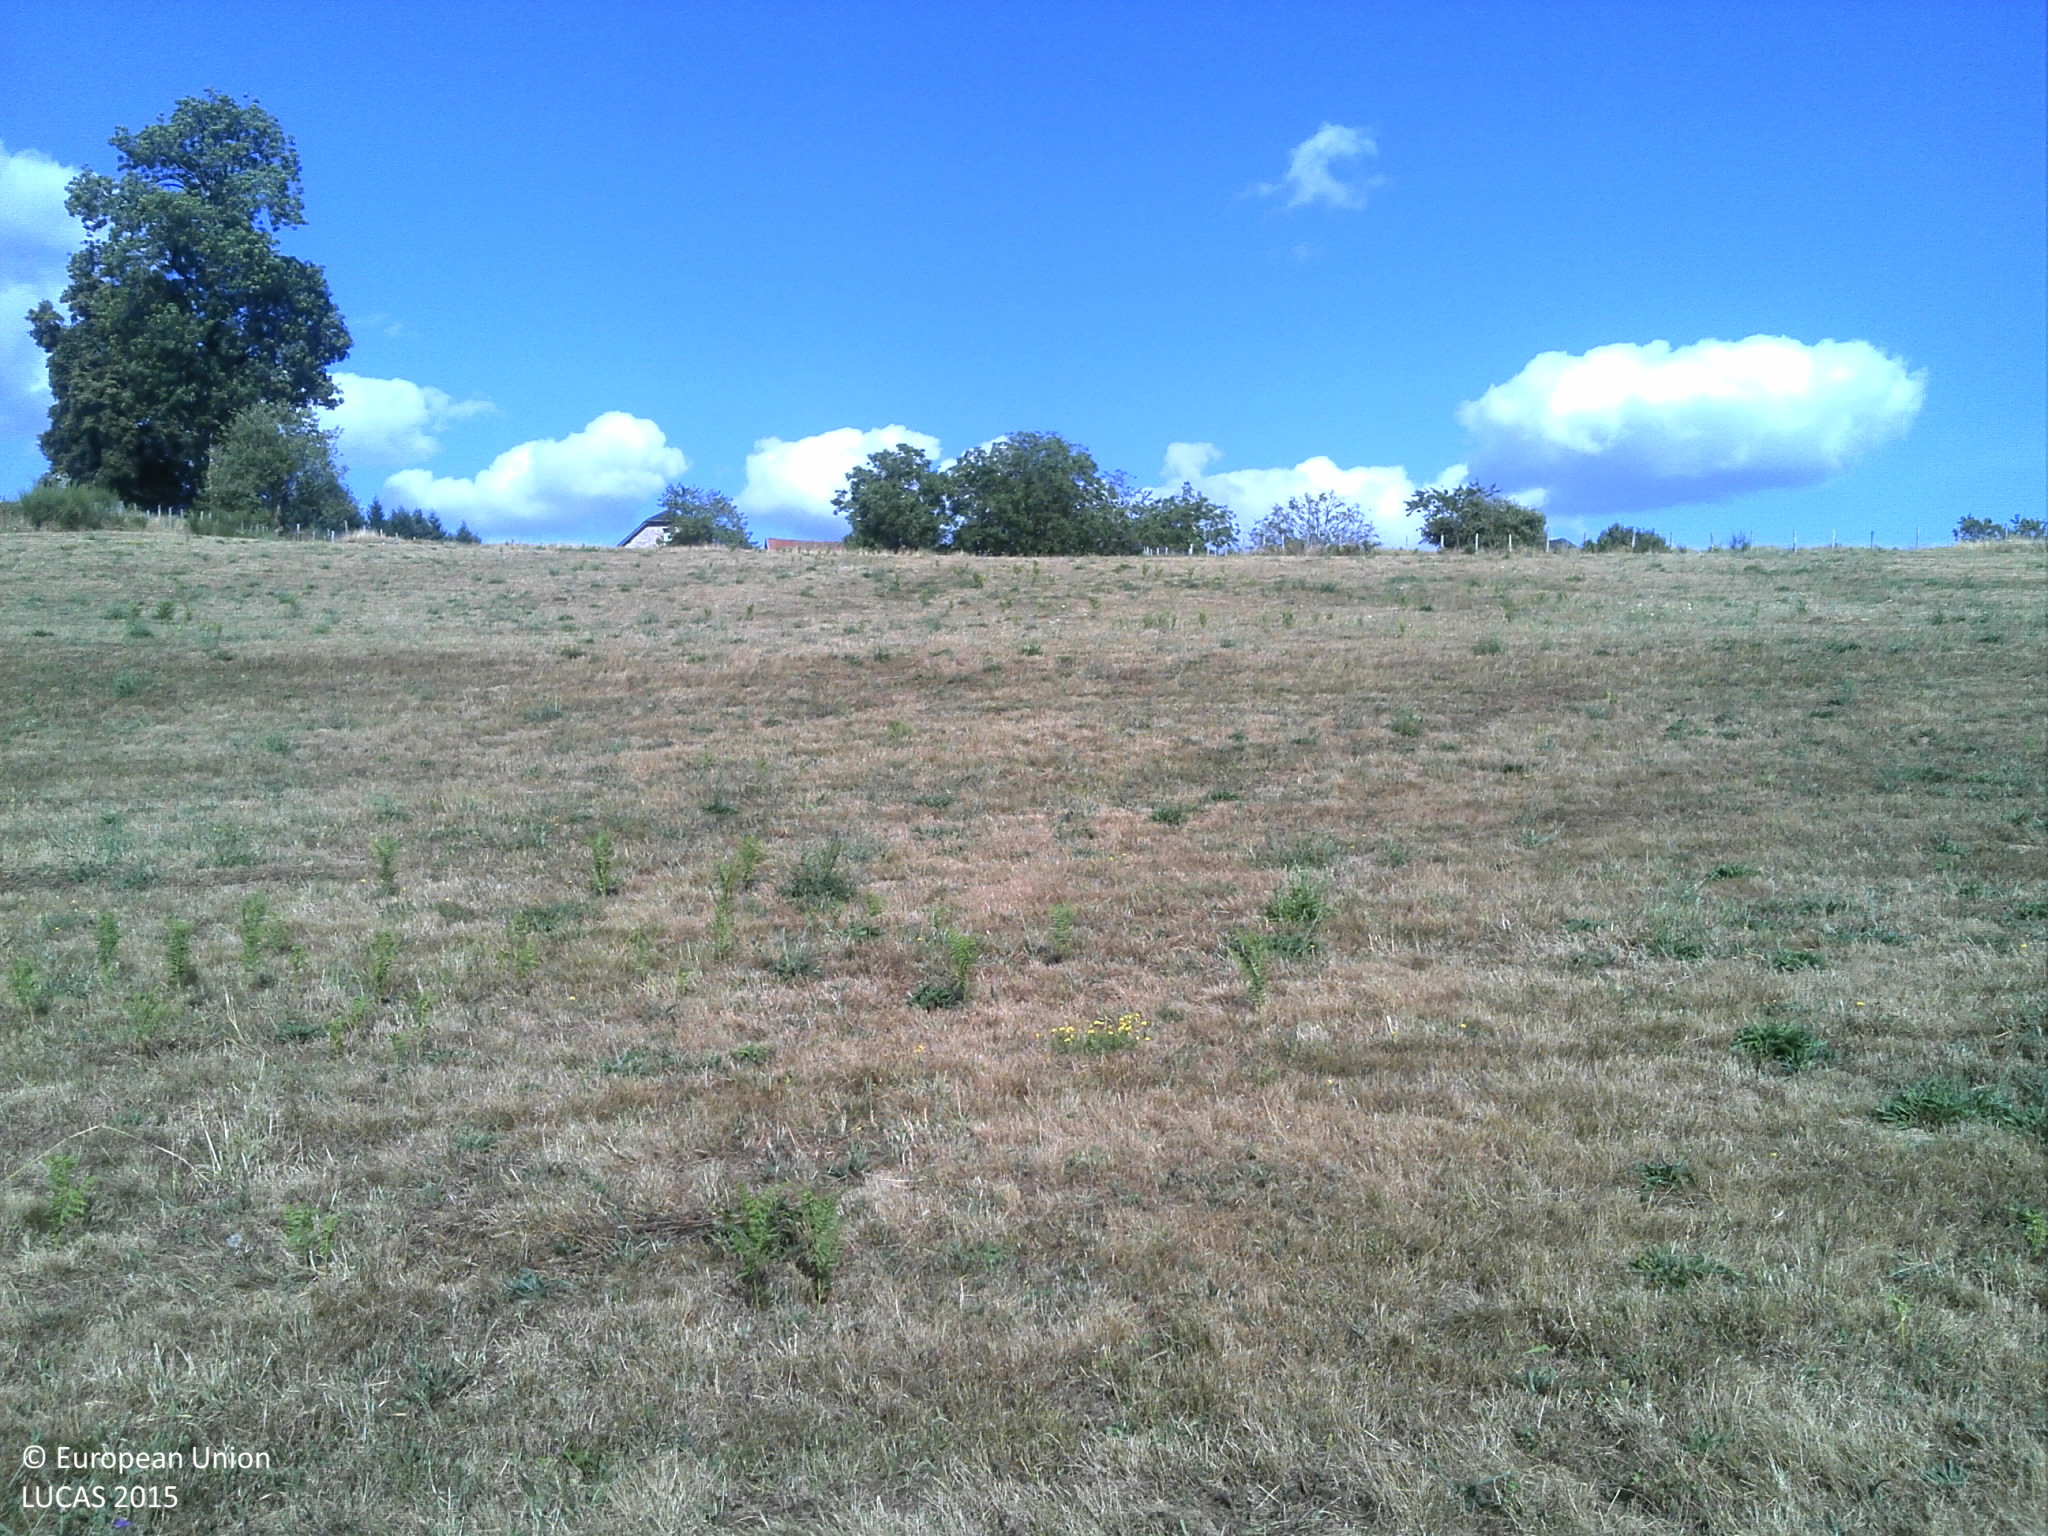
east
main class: Grassland
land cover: Grassland without tree/shrub cover
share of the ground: > 75 %
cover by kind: herbaceous plants 100 %
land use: Agriculture (excluding fallow land and kitchen gardens)
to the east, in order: Grassland without tree/shrub cover; Fences; Tracks; Grassland with sparse tree/shrub cover; Artificial constructions in urban areas; Grassland with sparse tree/shrub cover; Artificial constructions in urban areas; Grassland with sparse tree/shrub cover
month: July
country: FR
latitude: 45.1801
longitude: 1.7372
